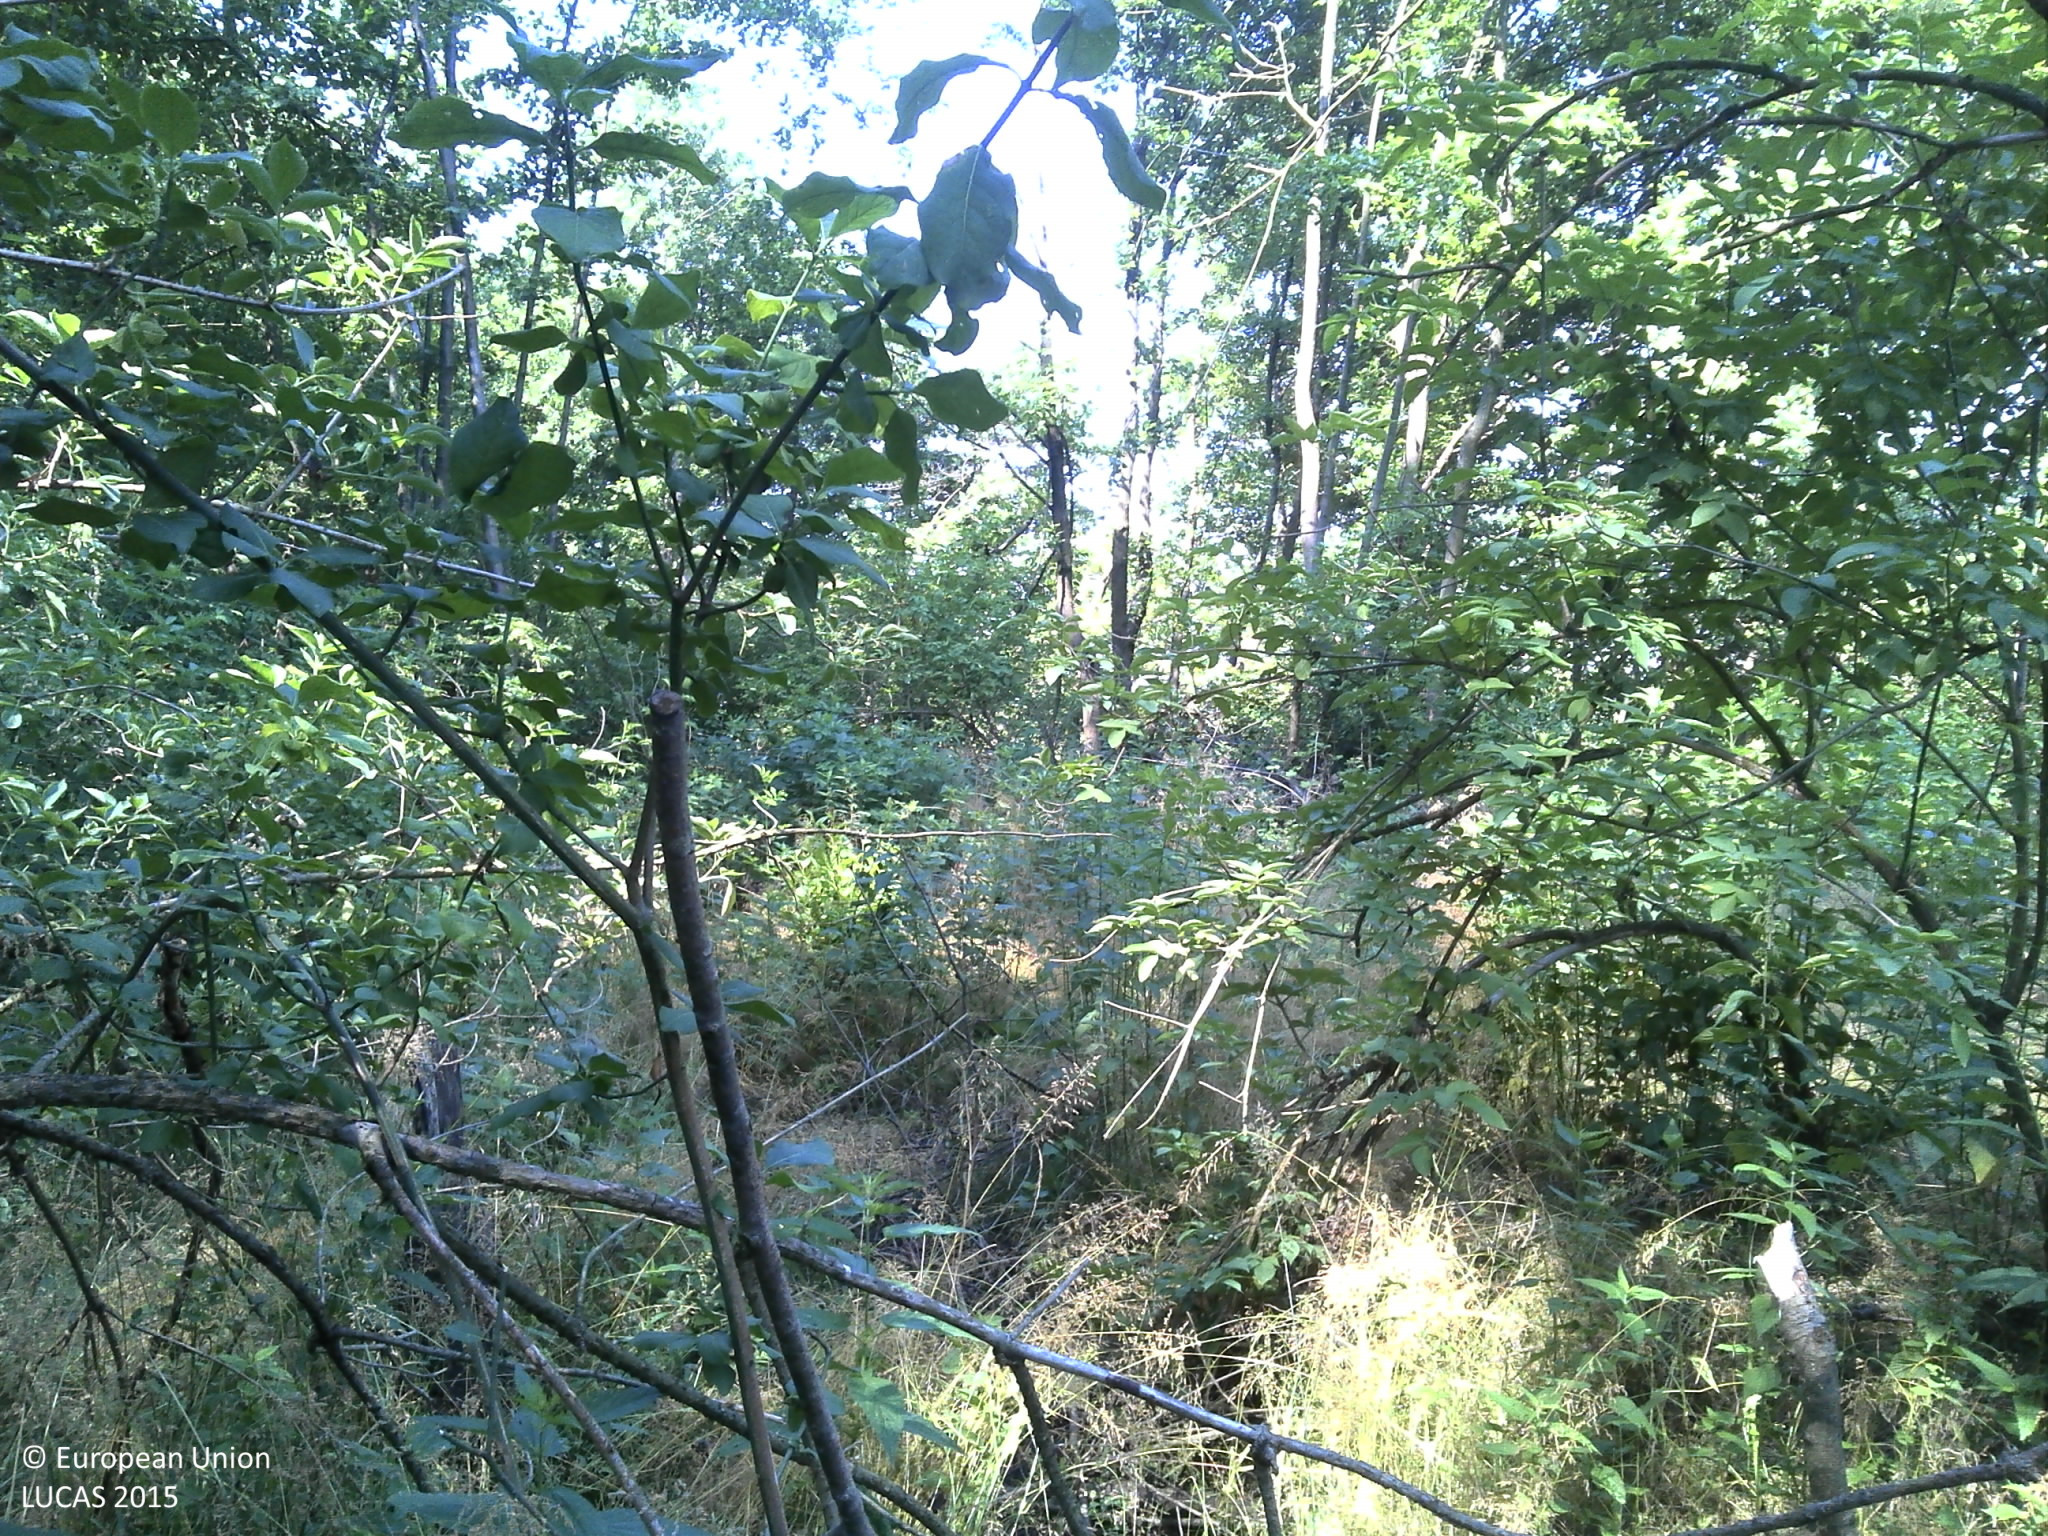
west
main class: Woodland
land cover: Broadleaved woodland
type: mesophytic deciduous forest
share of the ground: > 75 %
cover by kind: broadleaved forest trees 95 %, shrubs 5 %
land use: Forestry
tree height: > 5 m
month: June
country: HR
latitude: 45.3724
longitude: 17.8810
